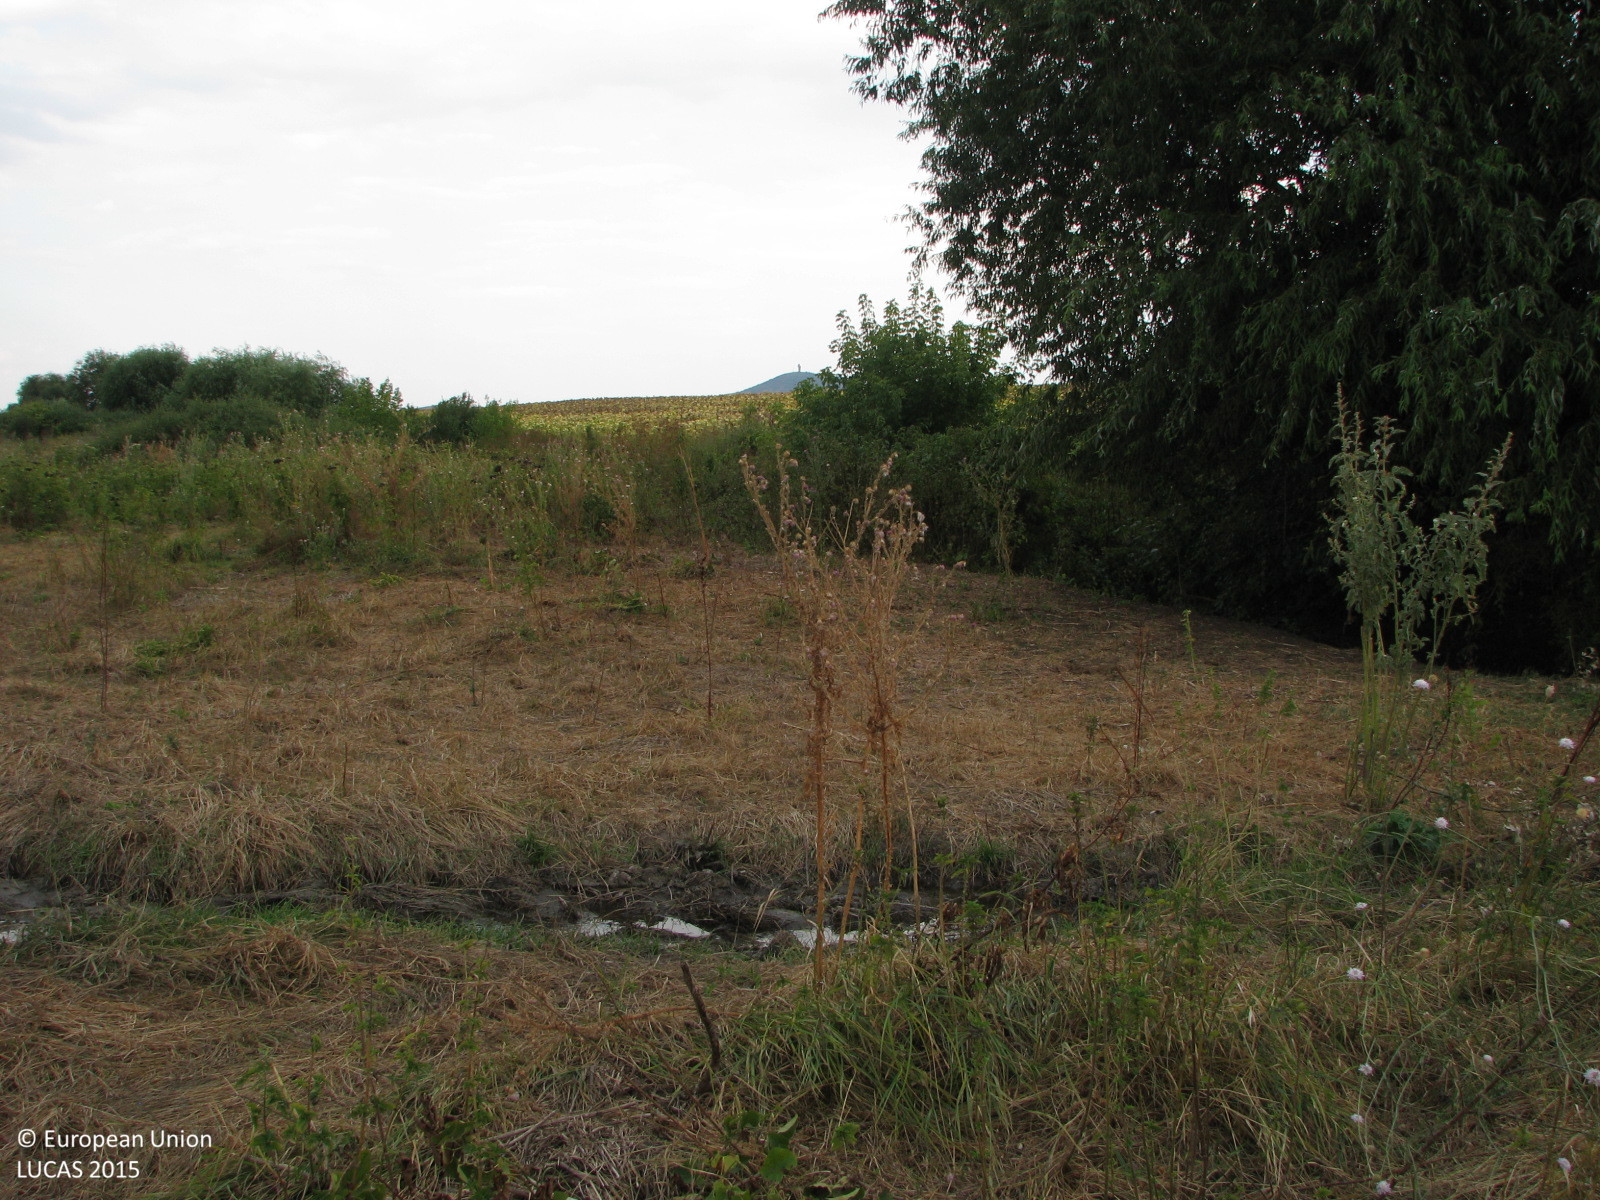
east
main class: Grassland
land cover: Grassland with sparse tree/shrub cover
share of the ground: > 75 %
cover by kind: herbaceous plants 90 %, coniferous forest trees 5 %, shrubs 5 %
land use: Agriculture (excluding fallow land and kitchen gardens)
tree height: > 5 m
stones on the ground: < 10 %
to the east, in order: Grassland with sparse tree/shrub cover; Ditches and canals; Grass margins; Sunflower
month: August
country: BG
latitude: 42.4378
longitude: 26.5651
